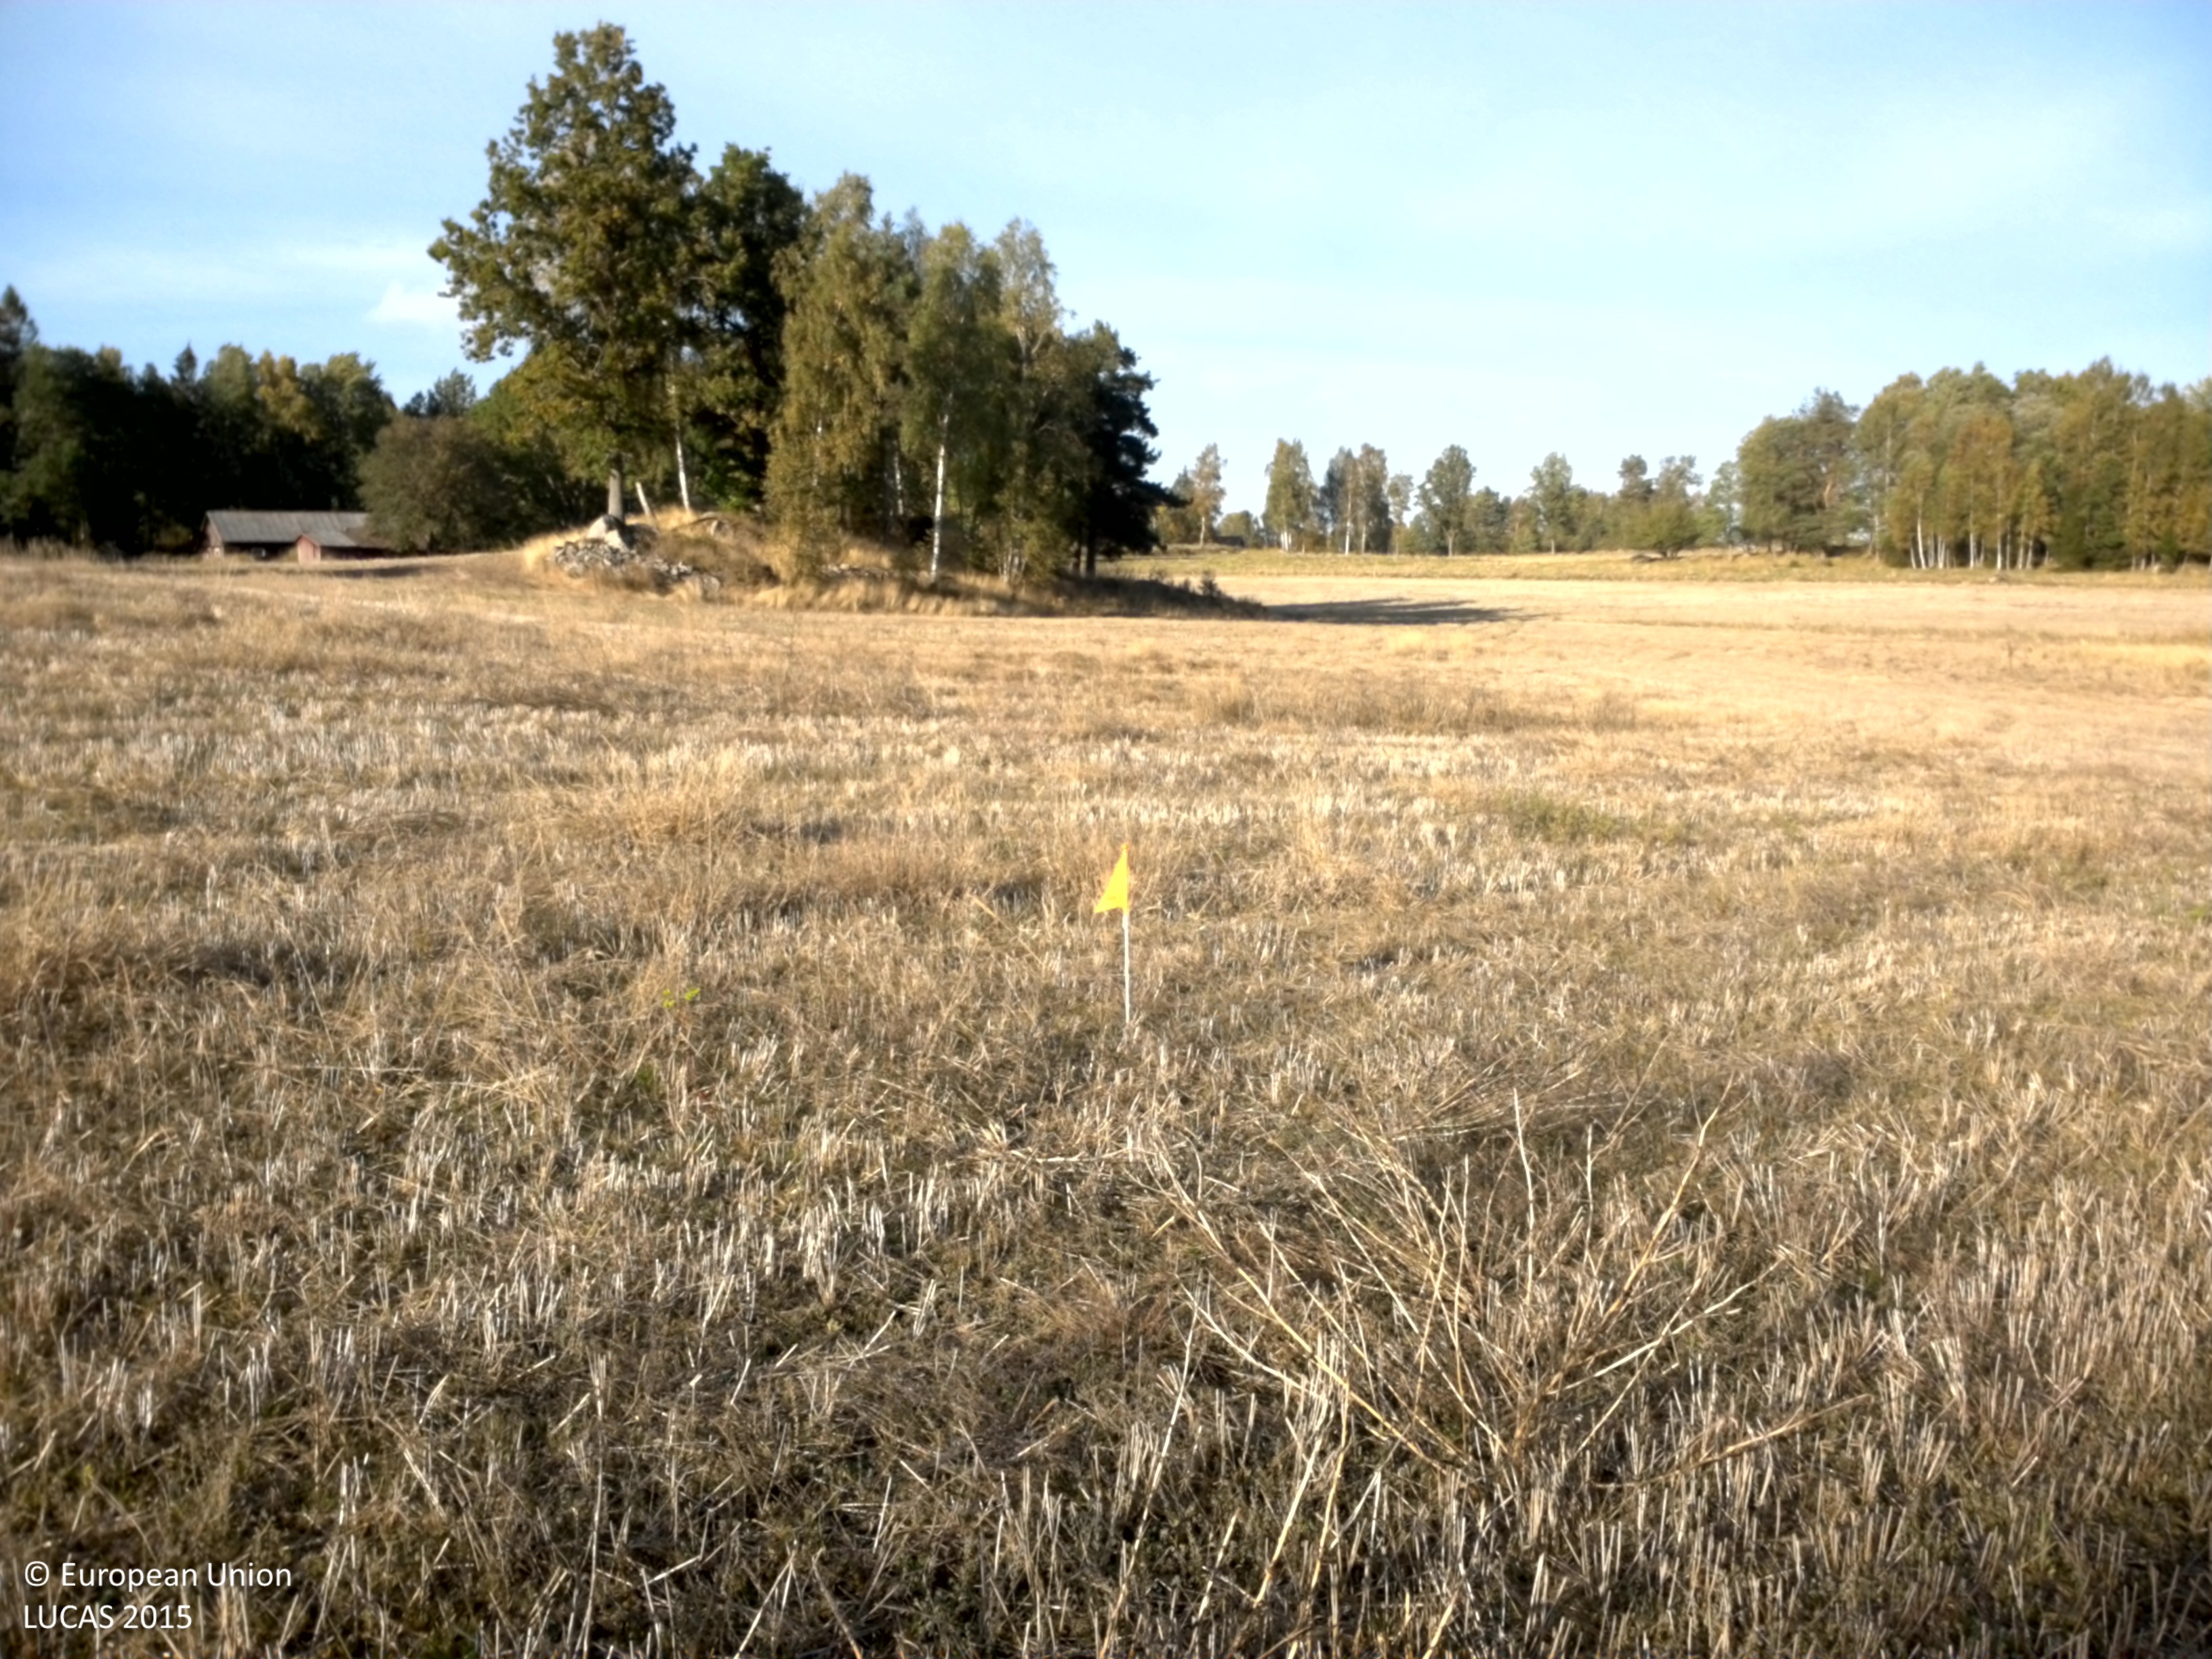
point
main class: Cropland
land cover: Other fibre and oleaginous crops
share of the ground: > 75 %
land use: Agriculture (excluding fallow land and kitchen gardens)
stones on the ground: < 10 %
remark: Harvested field
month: October
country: SE
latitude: 58.1492
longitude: 13.0361
